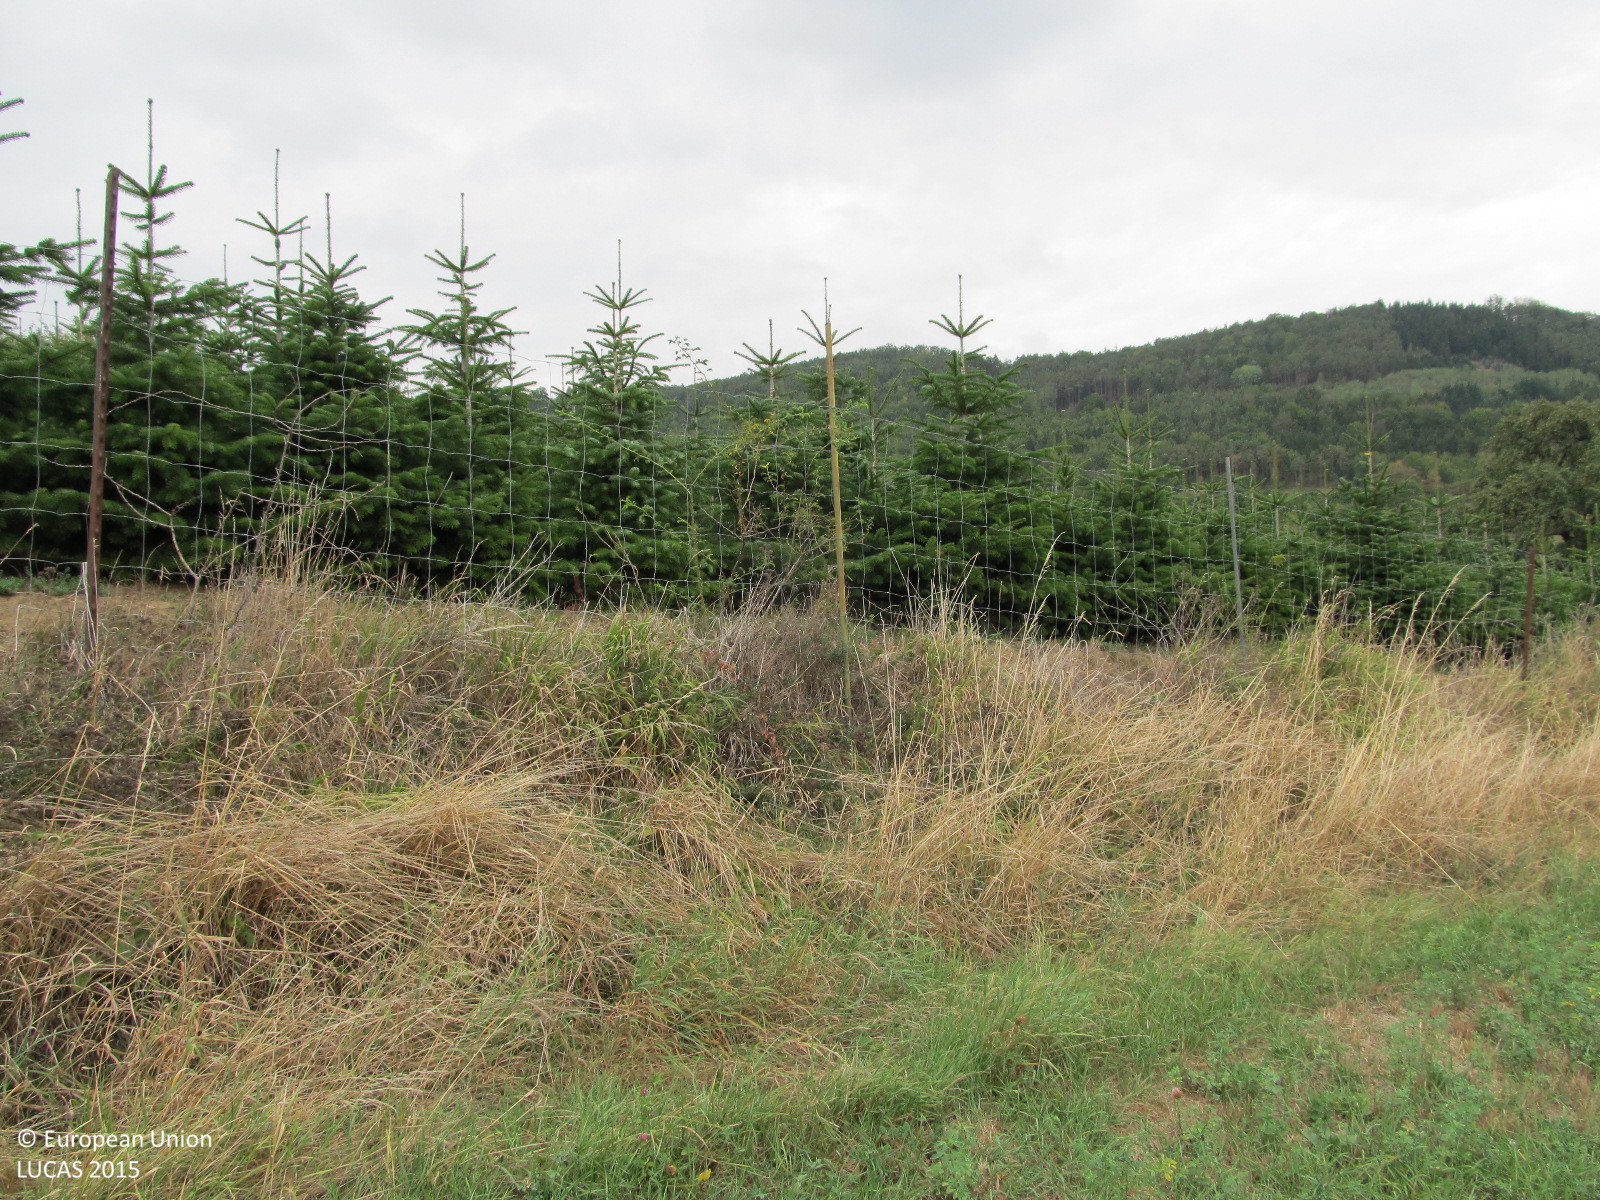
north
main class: Woodland
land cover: Spruce dominated coniferous woodland
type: hemiboreal forest and nemoral coniferous forest and mixed broadleaved-coniferous forest
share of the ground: > 75 %
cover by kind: coniferous forest trees 85 %, herbaceous plants 15 %
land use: Forestry
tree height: < 5 m
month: September
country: AT
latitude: 48.3663
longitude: 15.3069
